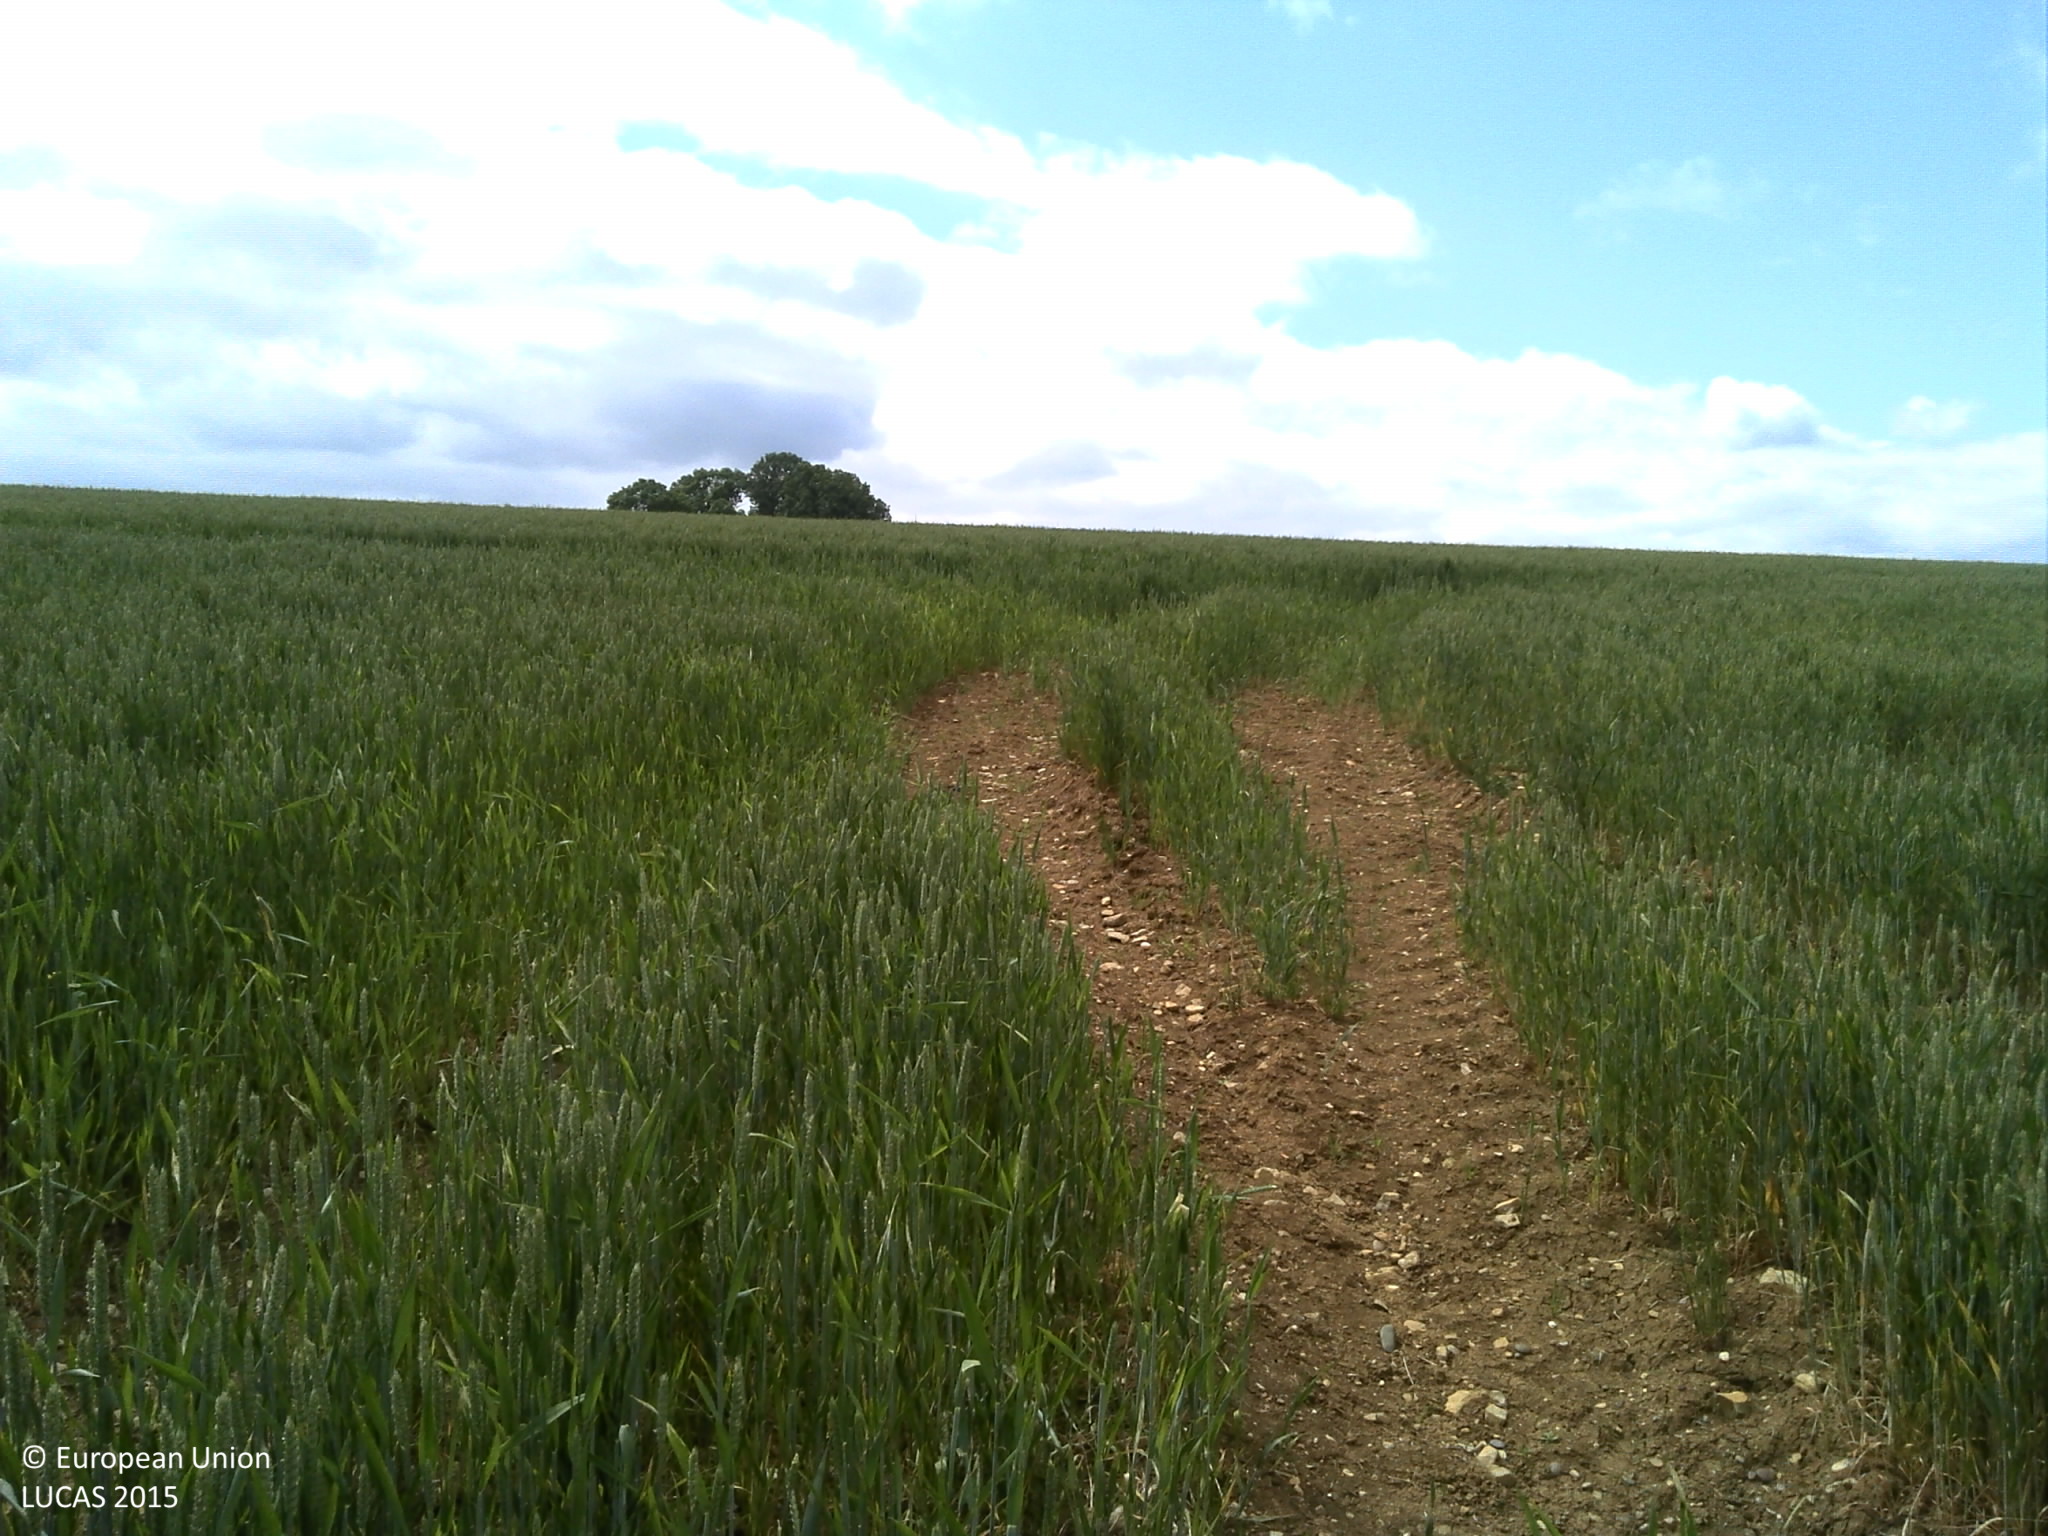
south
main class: Cropland
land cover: Common wheat
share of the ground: > 75 %
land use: Agriculture (excluding fallow land and kitchen gardens)
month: June
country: FR
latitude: 49.0051
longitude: 6.2132
